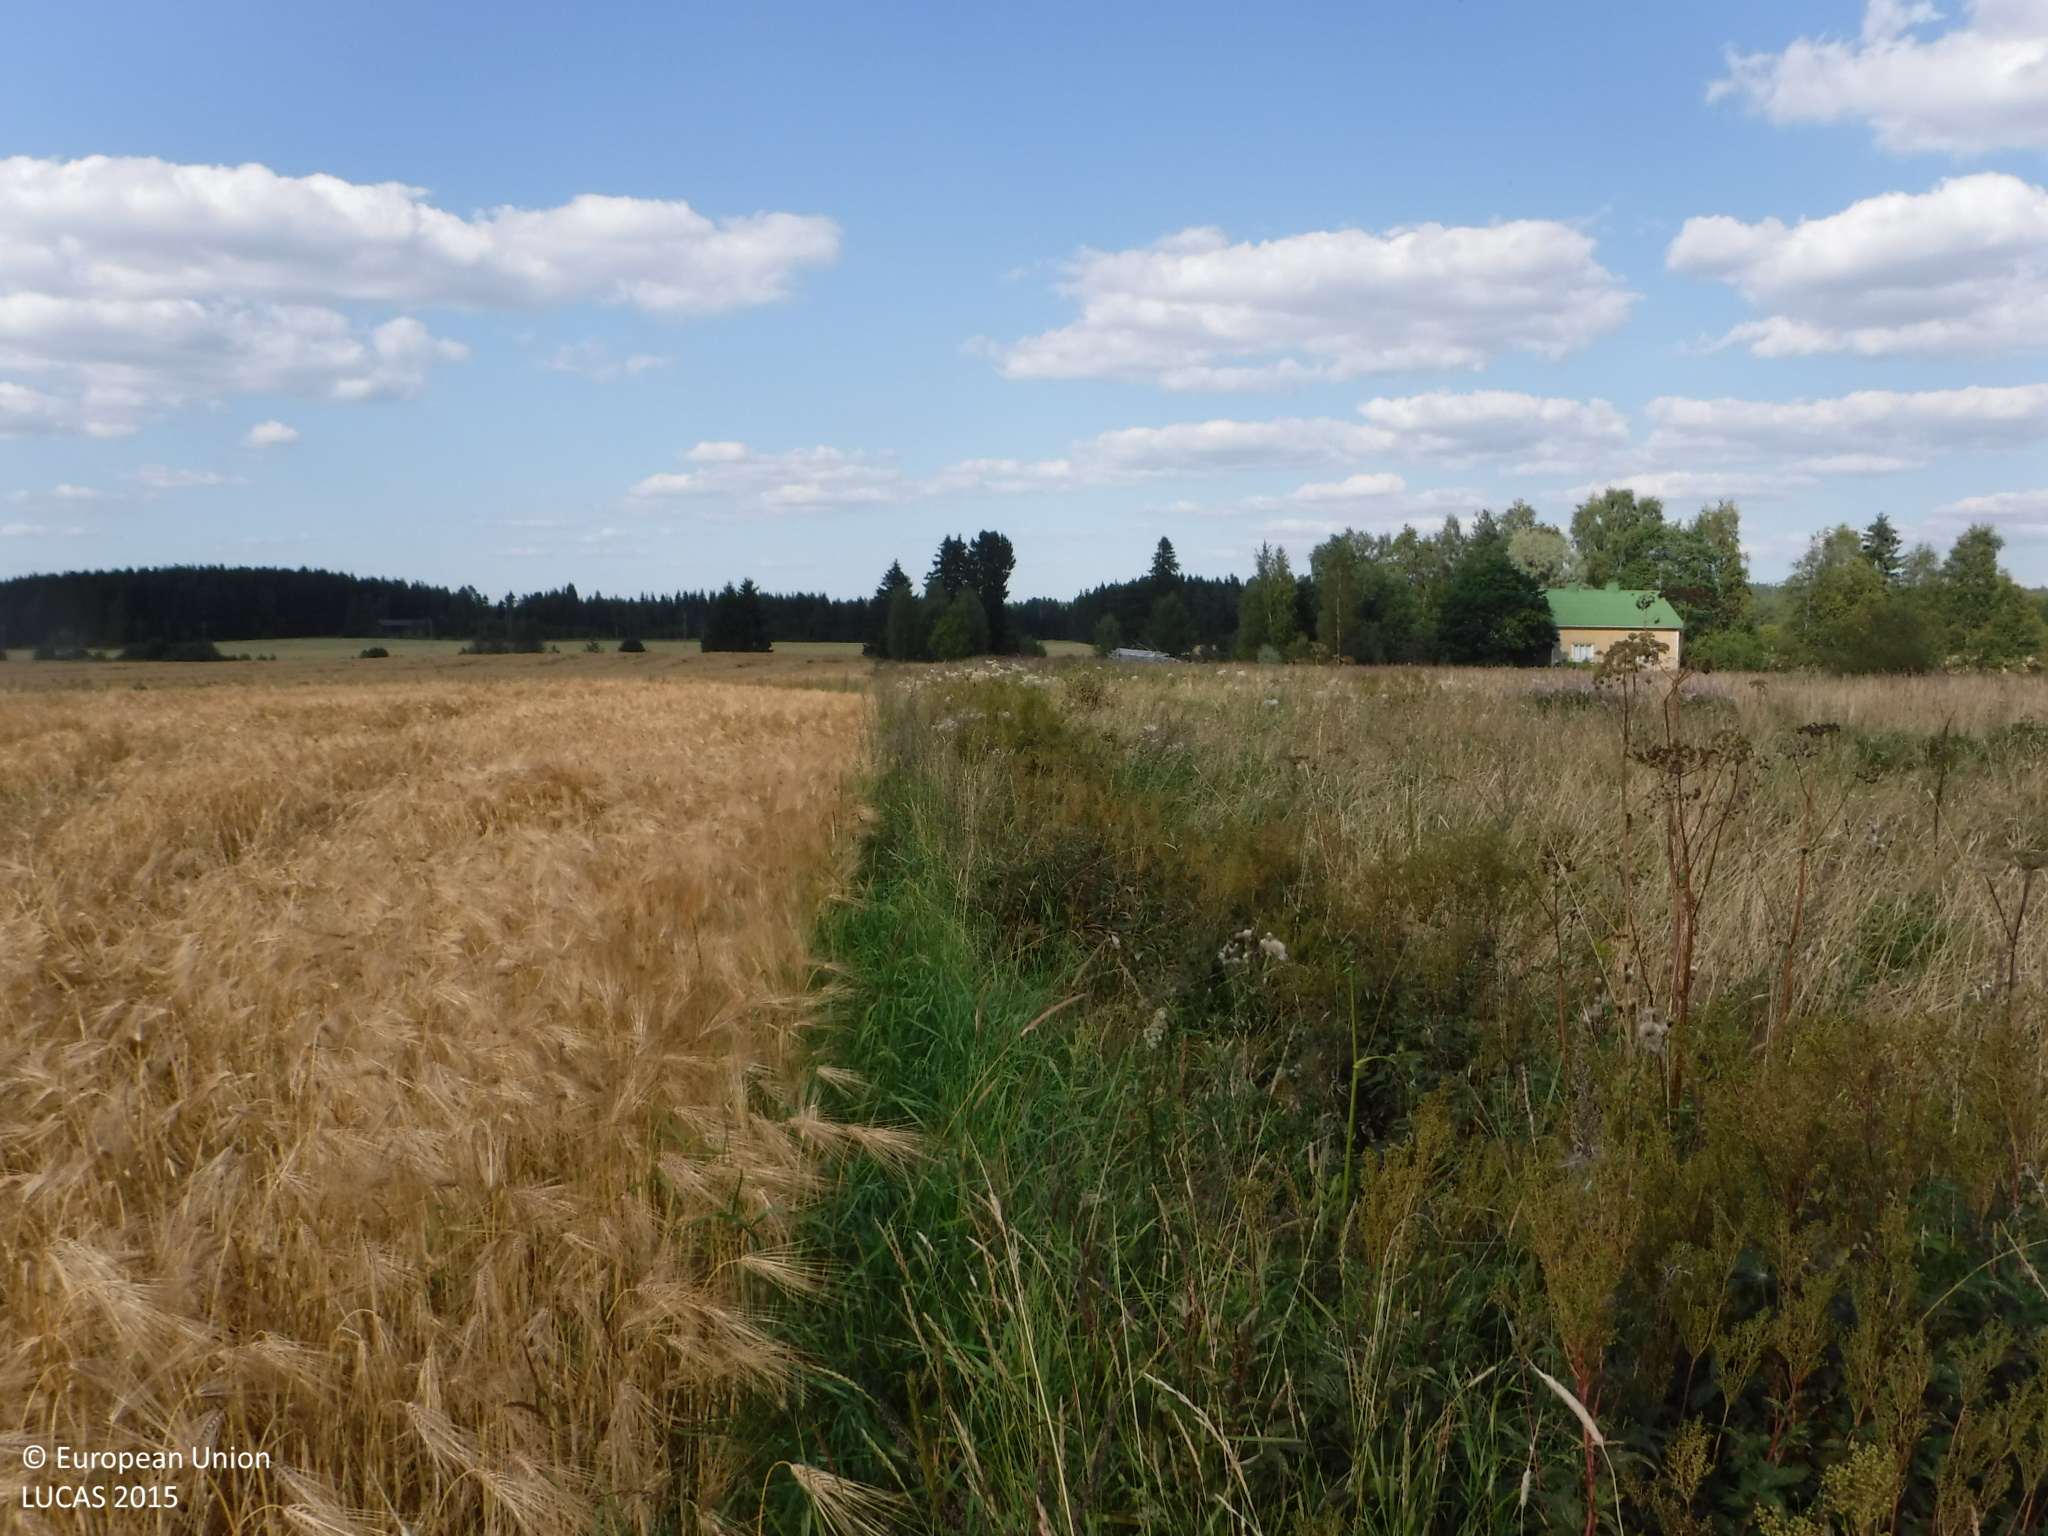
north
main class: Cropland
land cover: Barley
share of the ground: > 75 %
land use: Agriculture (excluding fallow land and kitchen gardens)
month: August
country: FI
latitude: 61.1389
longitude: 22.9054
